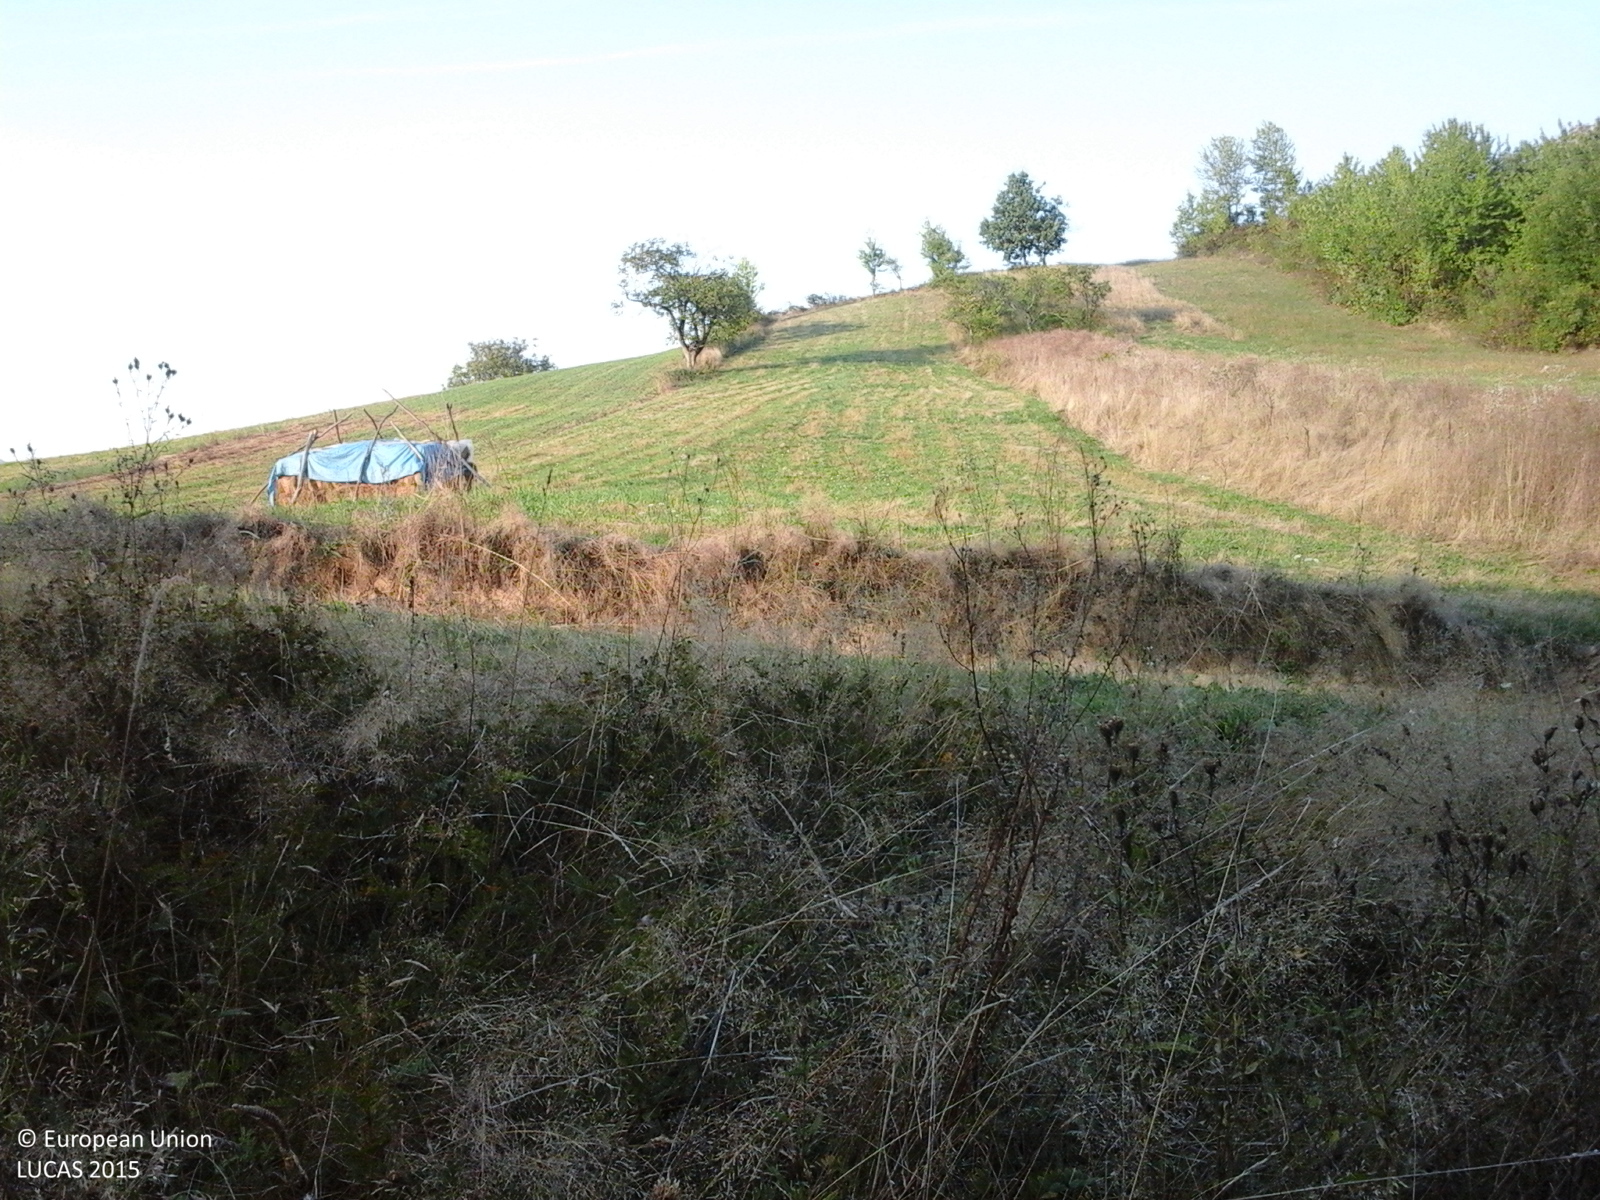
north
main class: Grassland
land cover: Grassland without tree/shrub cover
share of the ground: > 75 %
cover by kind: herbaceous plants 100 %
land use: Agriculture (excluding fallow land and kitchen gardens)
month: September
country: RO
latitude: 46.7322
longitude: 22.4444
